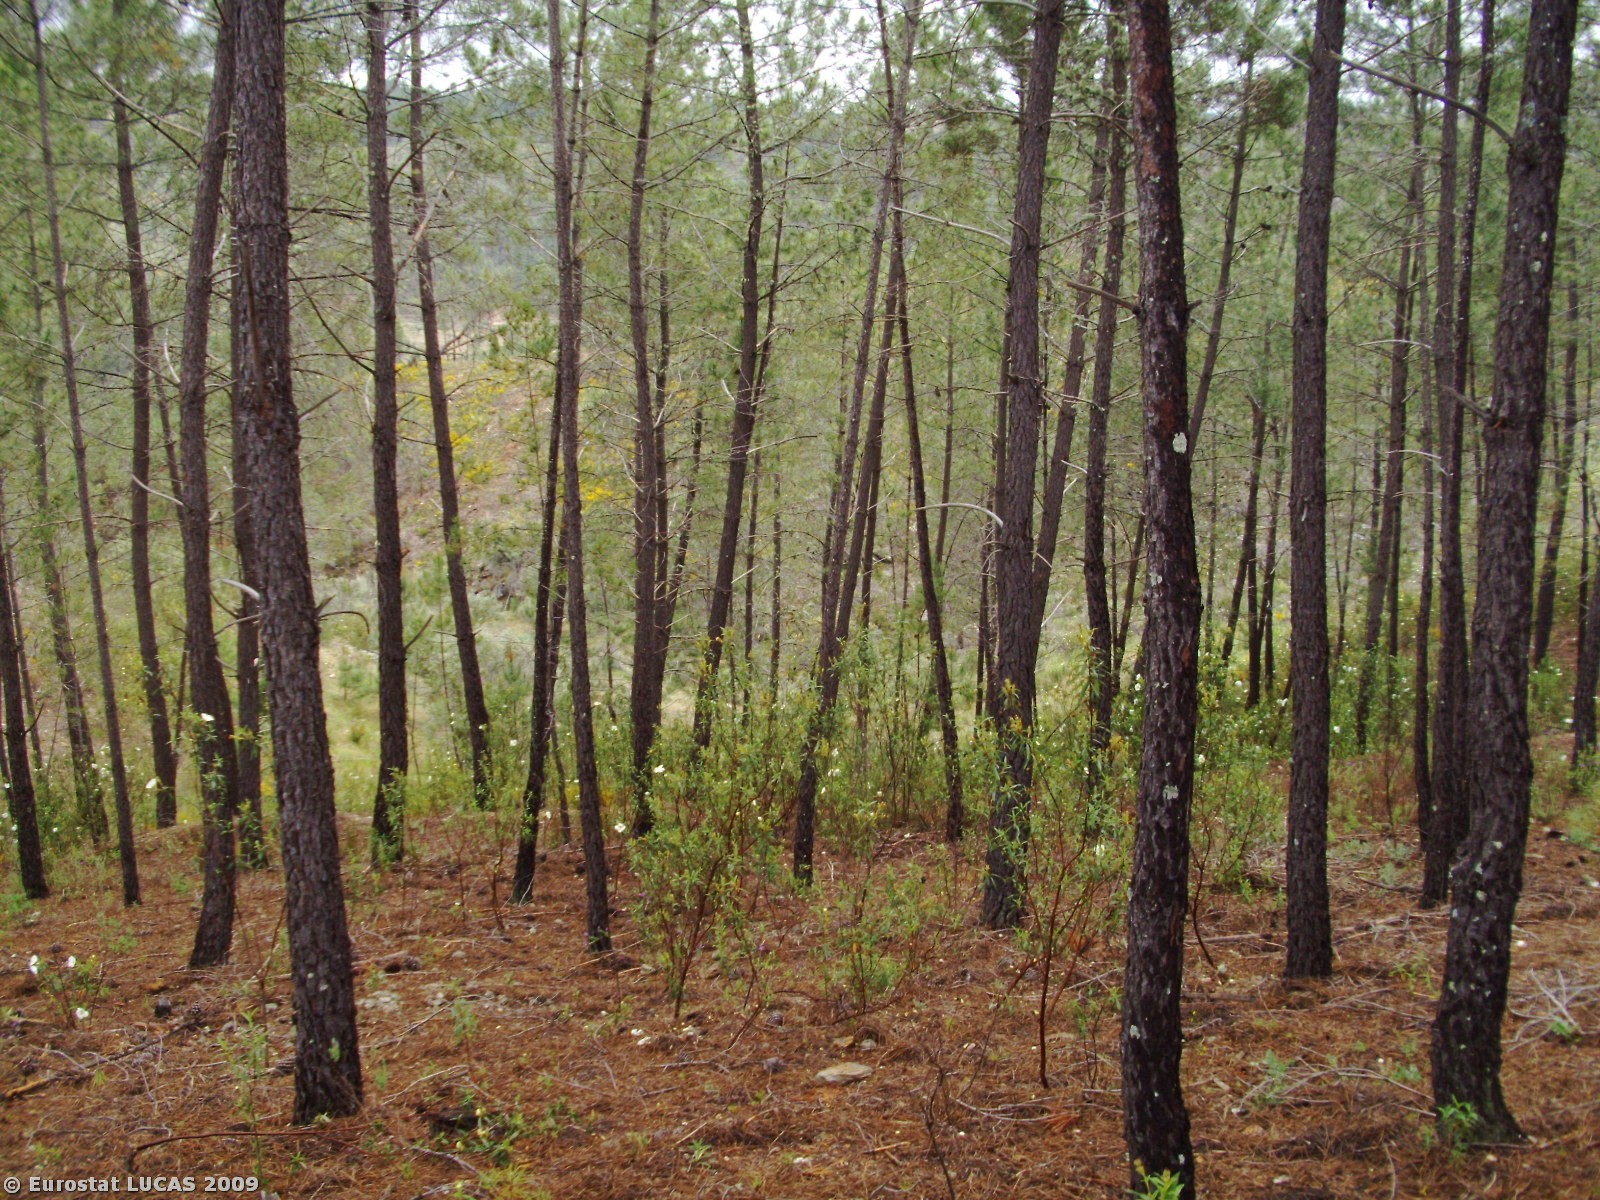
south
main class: Woodland
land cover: Coniferous woodland
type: coniferous forest of the mediterranean region
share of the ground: 50 - 75 %
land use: Forestry
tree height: > 5 m
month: April
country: PT
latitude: 39.8443
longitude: -7.5971
